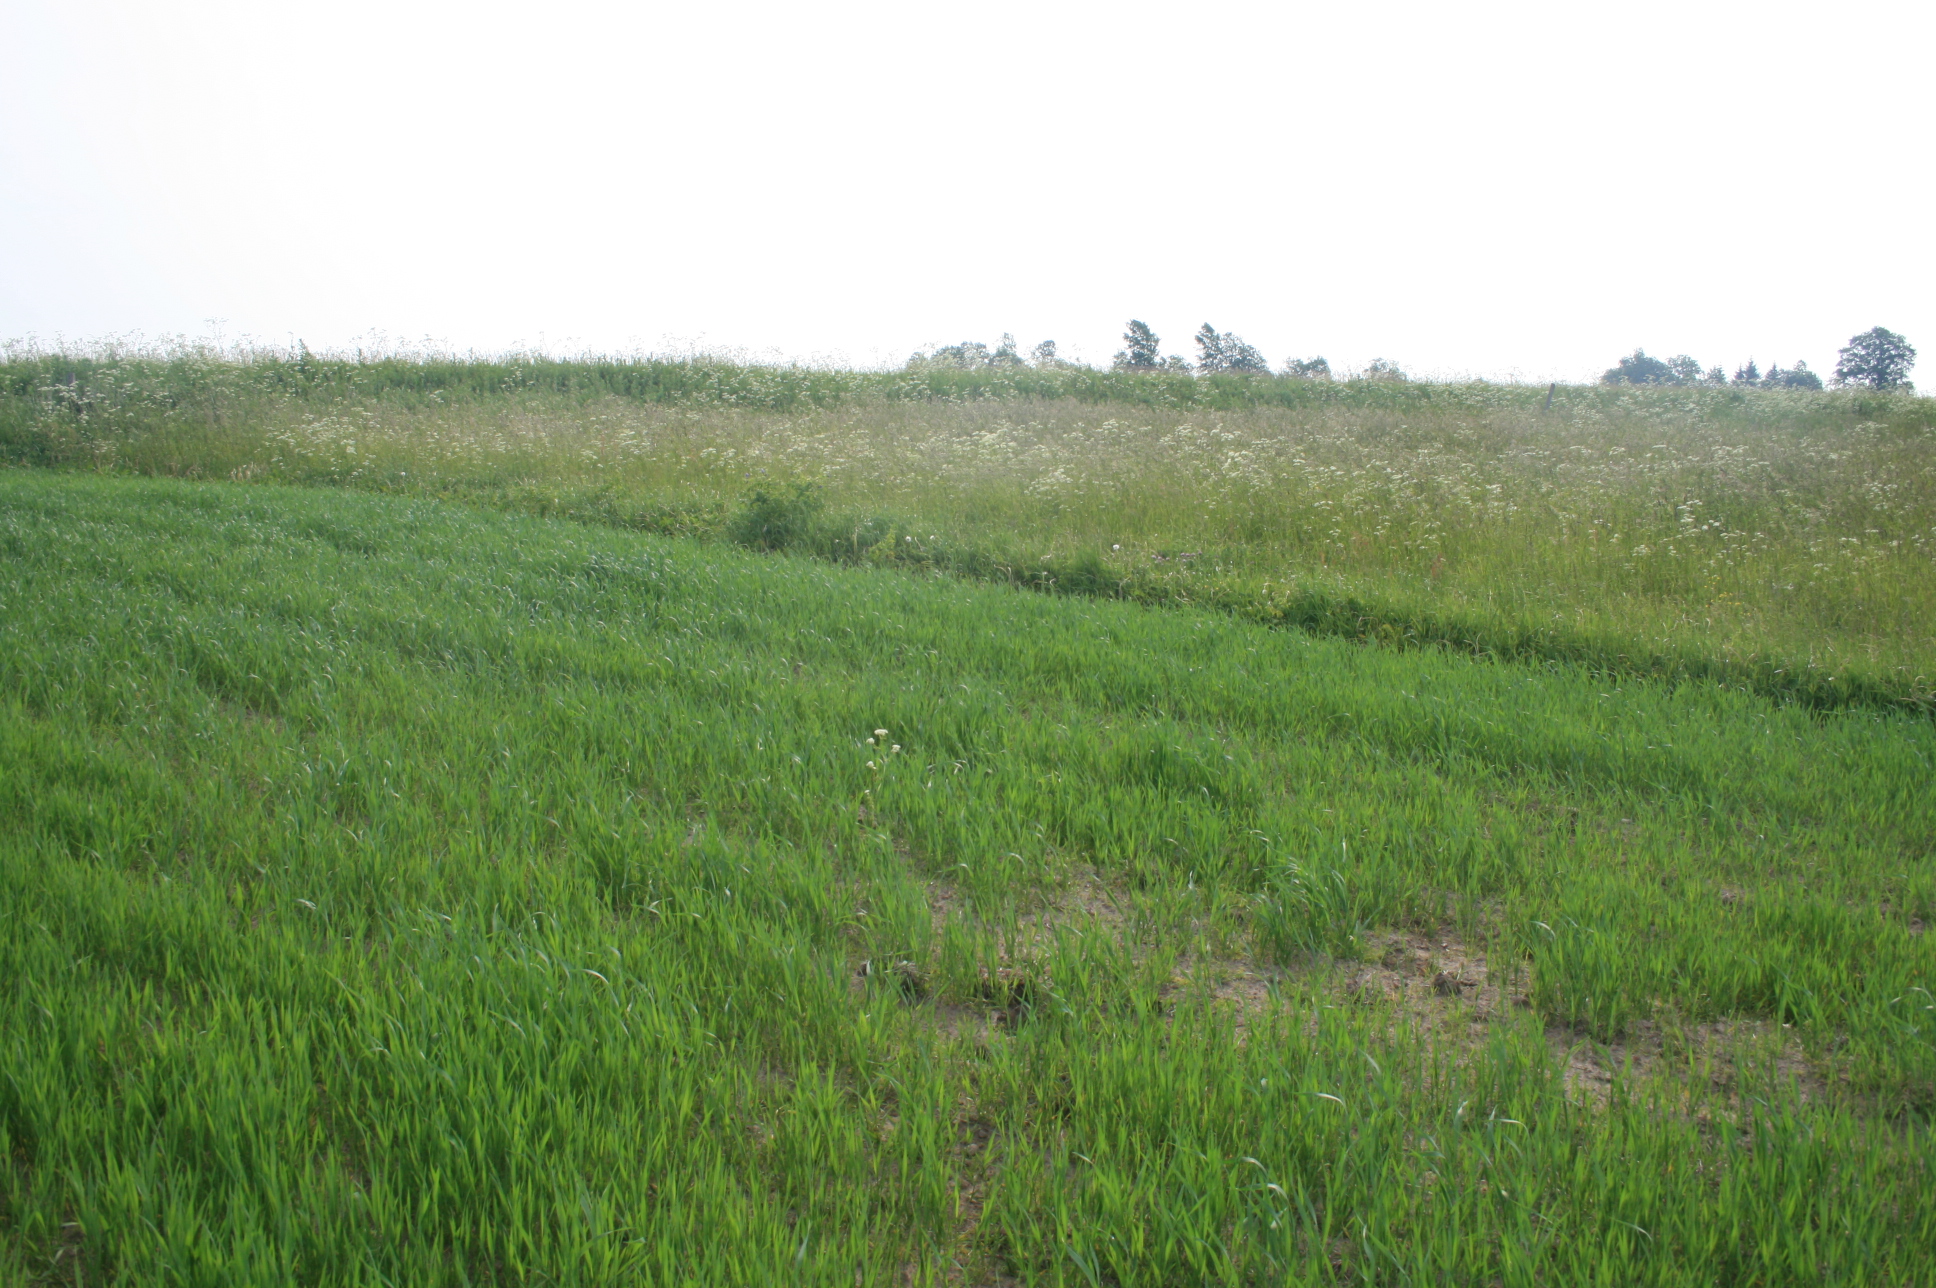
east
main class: Cropland
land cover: Common wheat
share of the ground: > 75 %
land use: Agriculture (excluding fallow land and kitchen gardens)
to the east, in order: Common wheat; Grassland without tree/shrub cover; Spontaneously vegetated surfaces; Paved roads, cycling and walking lanes; Spontaneously vegetated surfaces; Grassland without tree/shrub cover; Potatoes; Grassland without tree/shrub cover; Broadleaved woodland; Ditches and canals; Broadleaved woodland; Grassland without tree/shrub cover
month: June
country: LT
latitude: 55.7415
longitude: 22.2736
